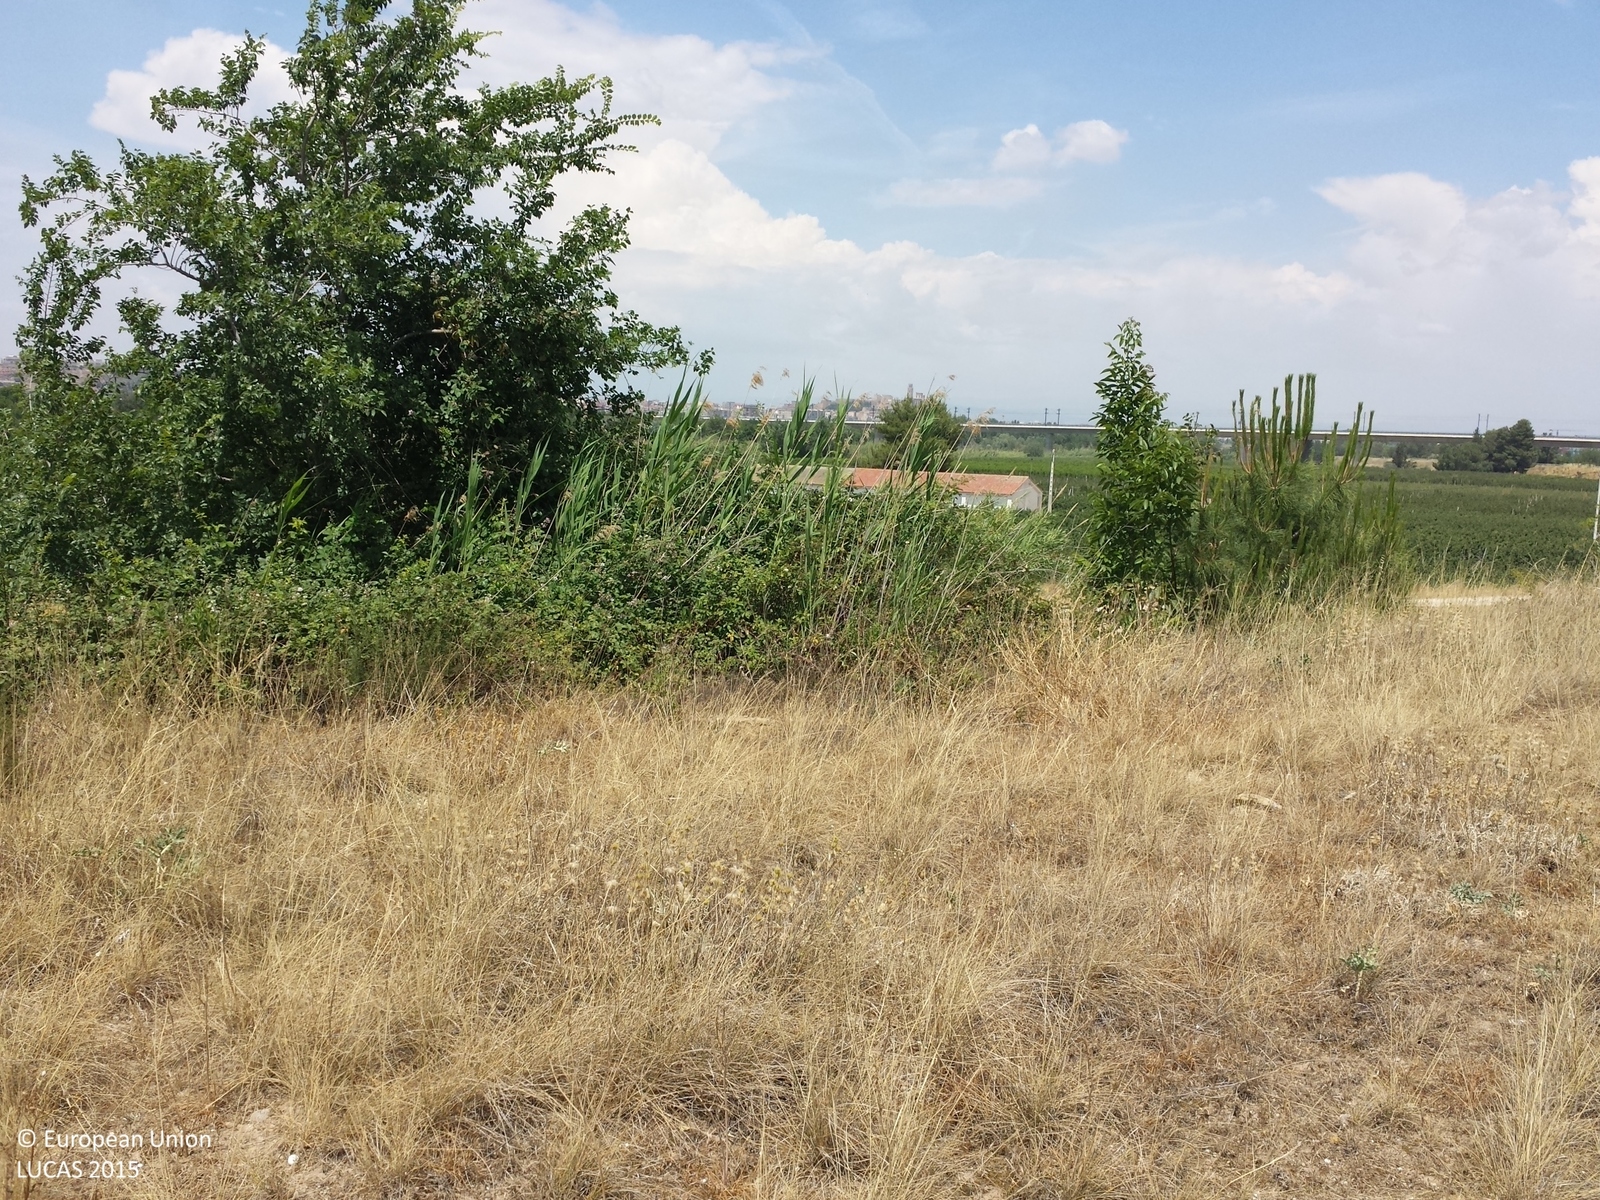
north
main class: Grassland
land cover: Grassland without tree/shrub cover
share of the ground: > 75 %
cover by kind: herbaceous plants 85 %, consolidated bare surface 10 %, shrubs 5 %
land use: Semi-natural and natural areas not in use
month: June
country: ES
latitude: 41.5818
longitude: 0.6202
